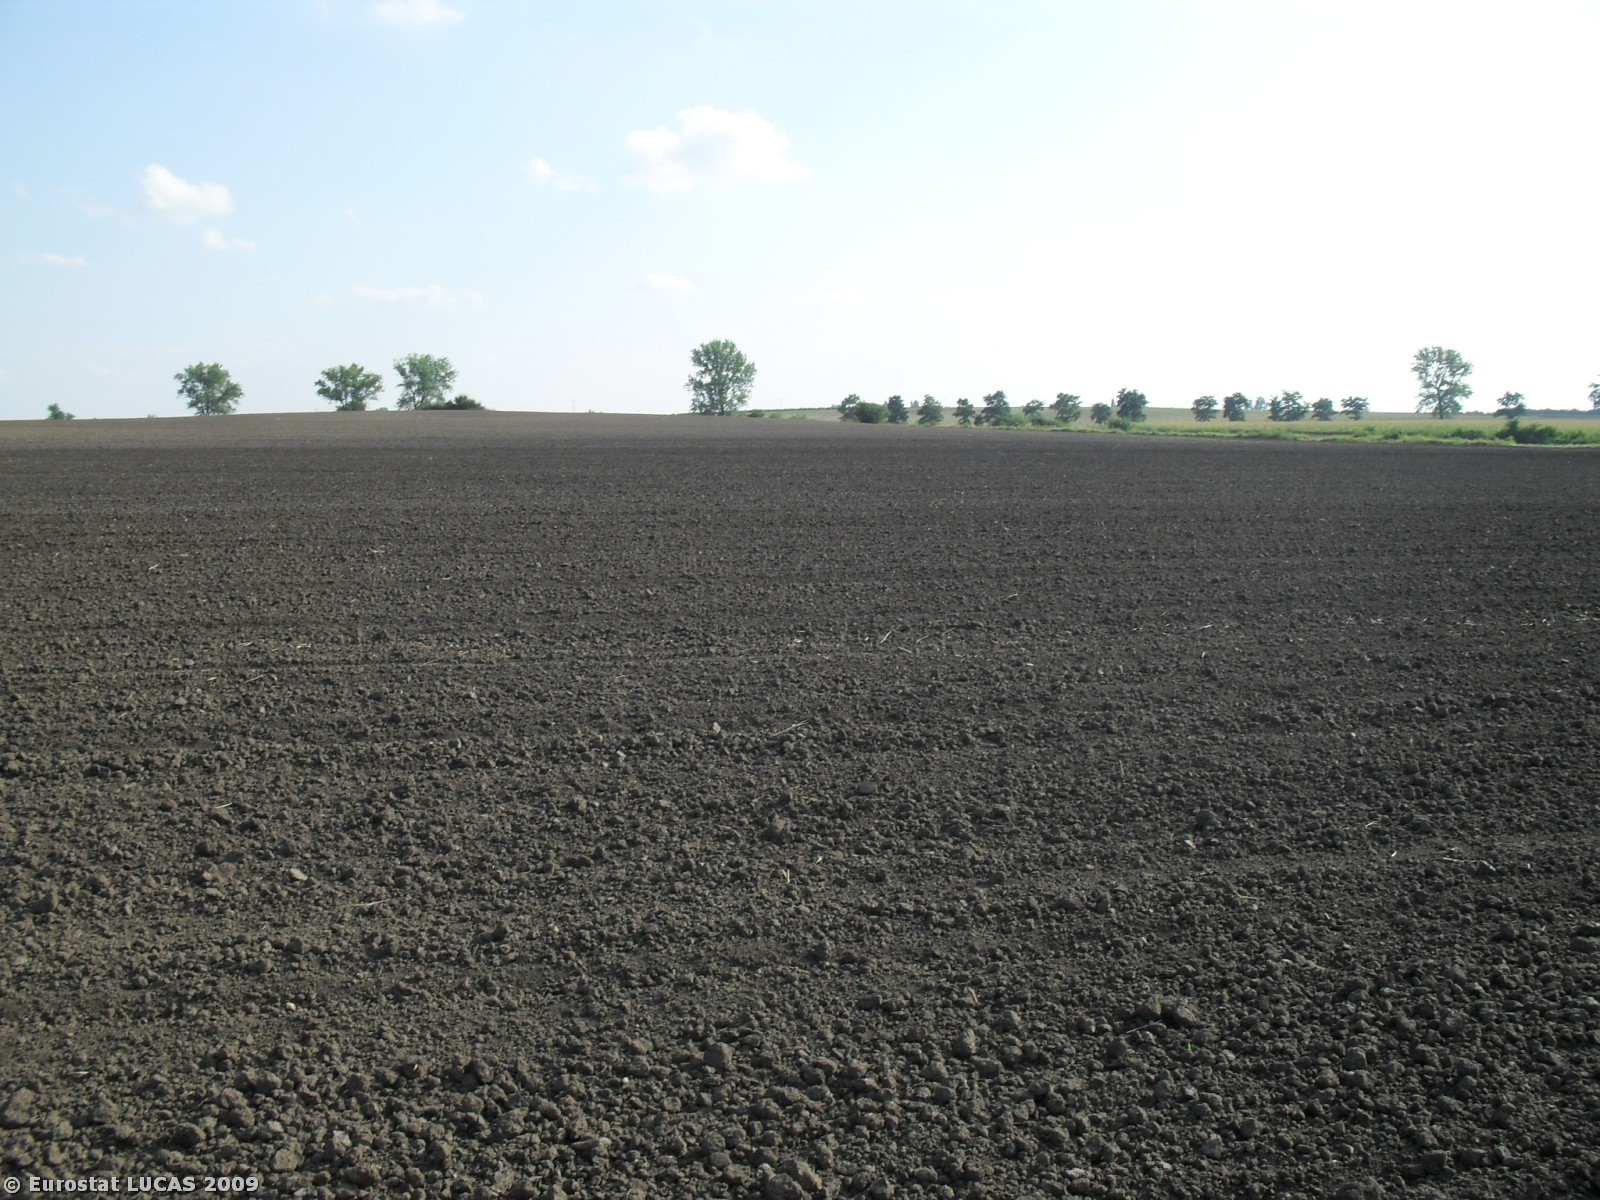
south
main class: Cropland
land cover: Common wheat
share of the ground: < 10 %
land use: Agriculture (excluding fallow land and kitchen gardens)
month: September
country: PL
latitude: 50.8208
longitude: 17.2365
